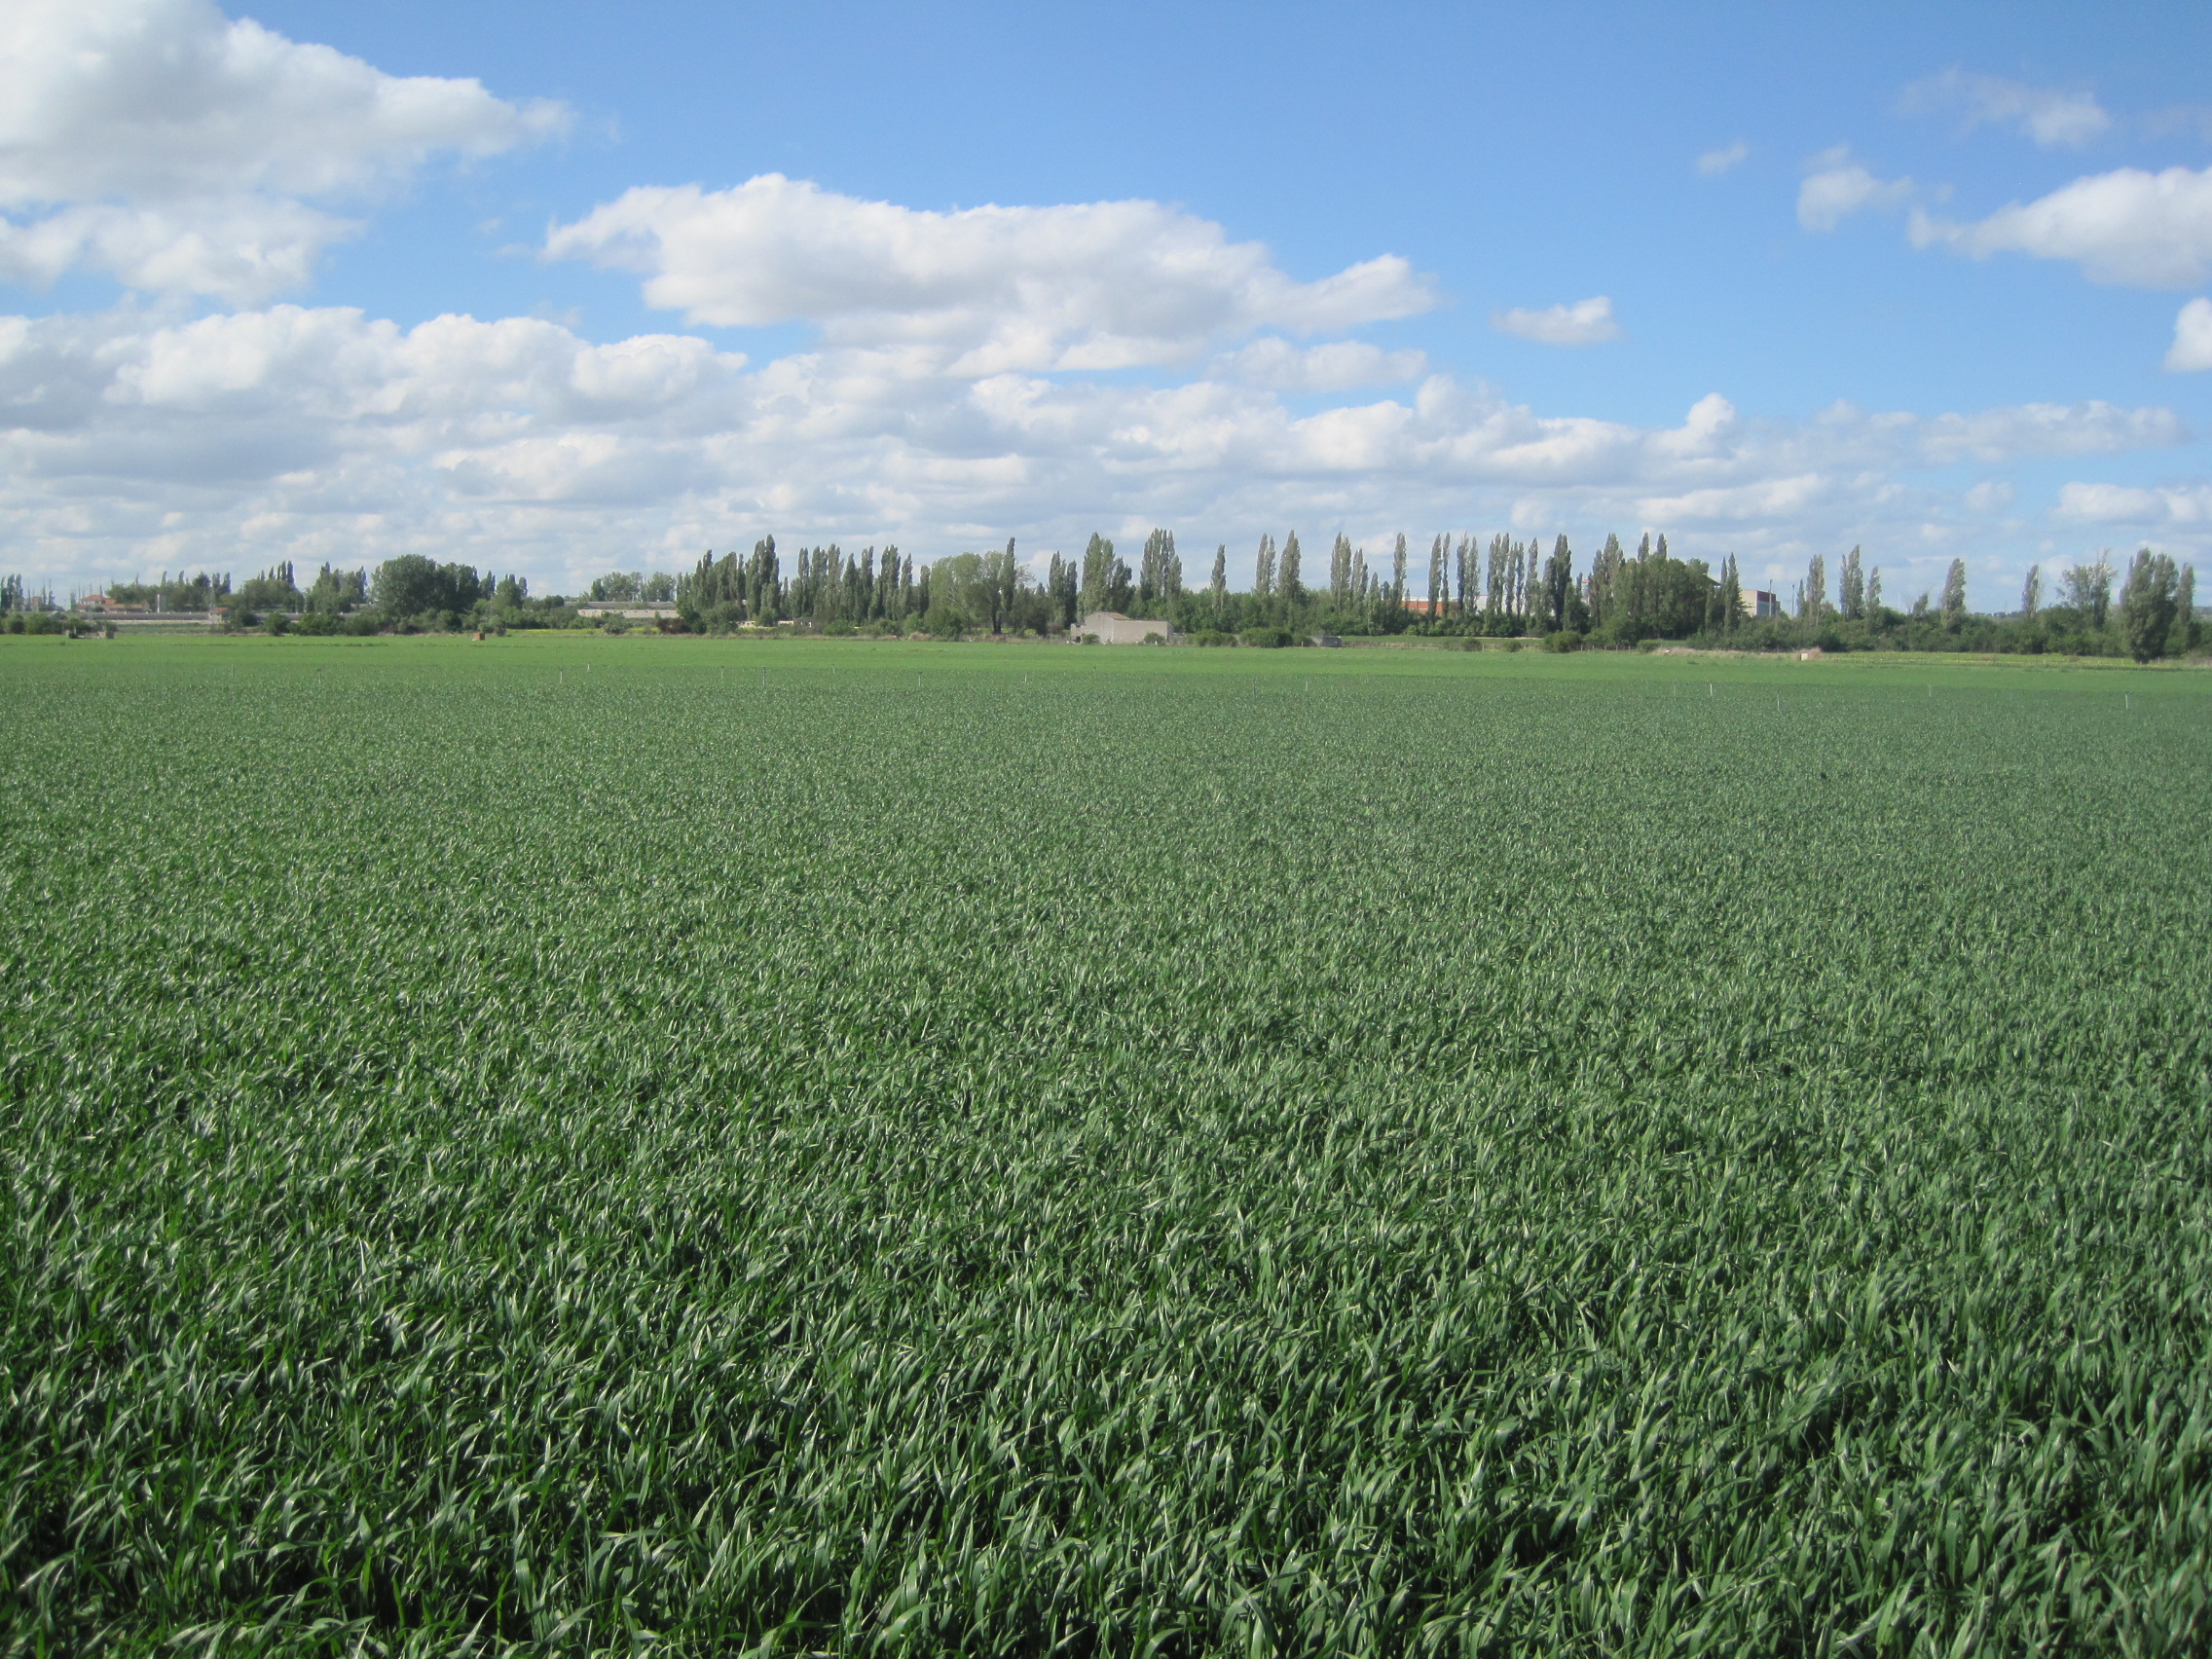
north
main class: Cropland
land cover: Common wheat
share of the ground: > 75 %
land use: Agriculture (excluding fallow land and kitchen gardens)
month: May
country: ES
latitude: 41.6509
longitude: -4.6813
